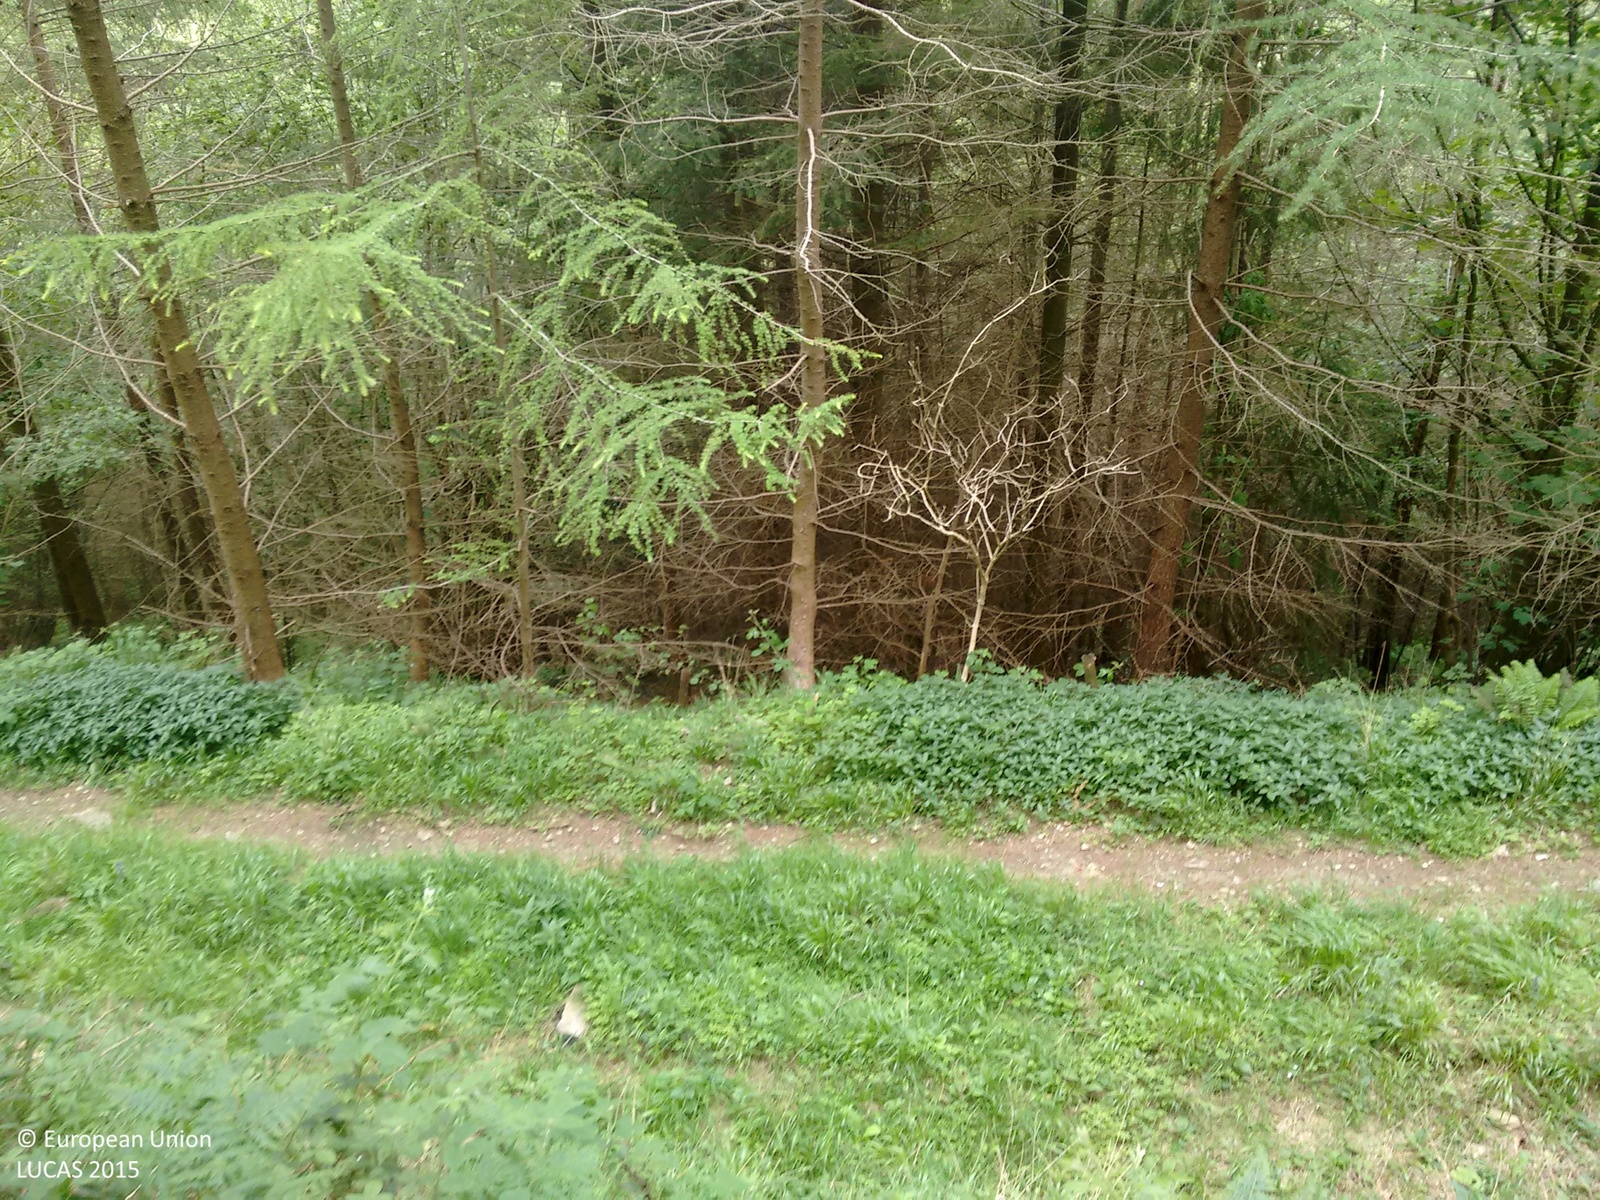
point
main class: Woodland
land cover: Pine dominated mixed woodland
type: exotic forest
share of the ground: > 75 %
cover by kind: coniferous forest trees 70 %, broadleaved forest trees 30 %
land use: Forestry
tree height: > 5 m
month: June
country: GB
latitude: 54.2712
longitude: -1.0840
